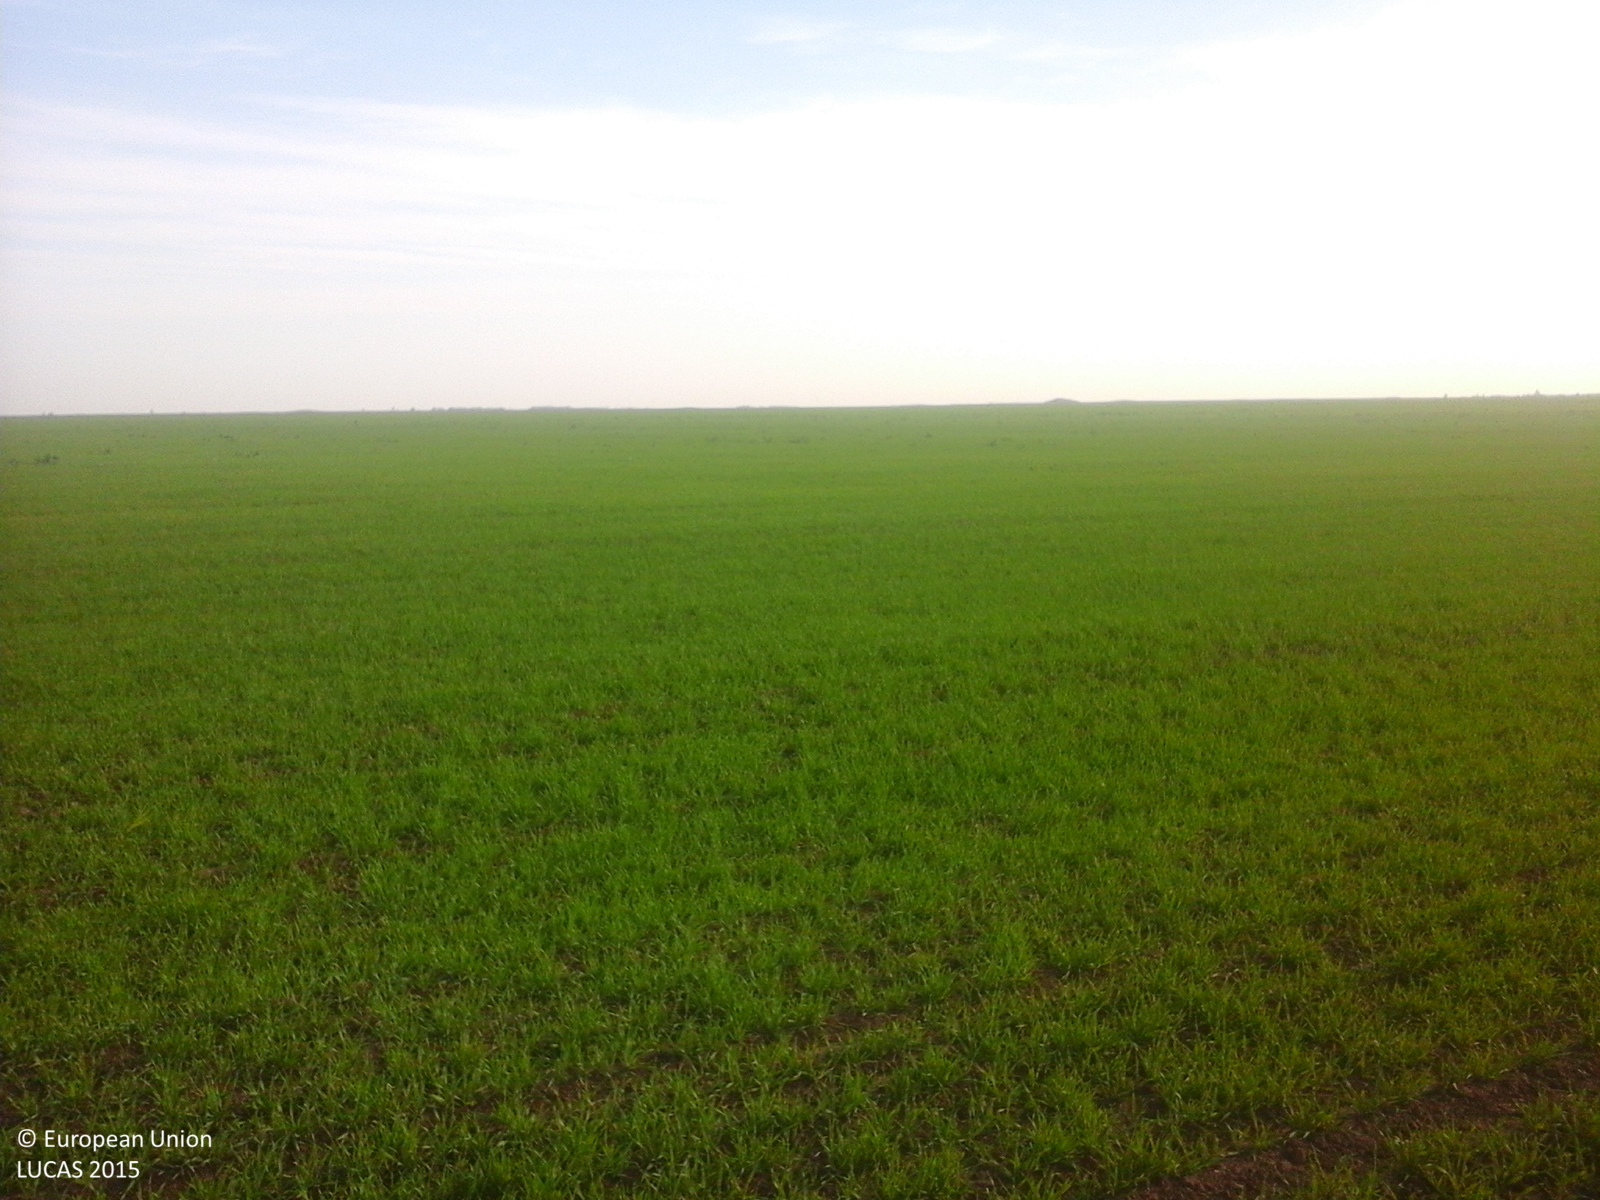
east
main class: Cropland
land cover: Common wheat
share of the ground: > 75 %
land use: Agriculture (excluding fallow land and kitchen gardens)
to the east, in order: Common wheat
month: October
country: RO
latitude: 45.2913
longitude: 27.2163
